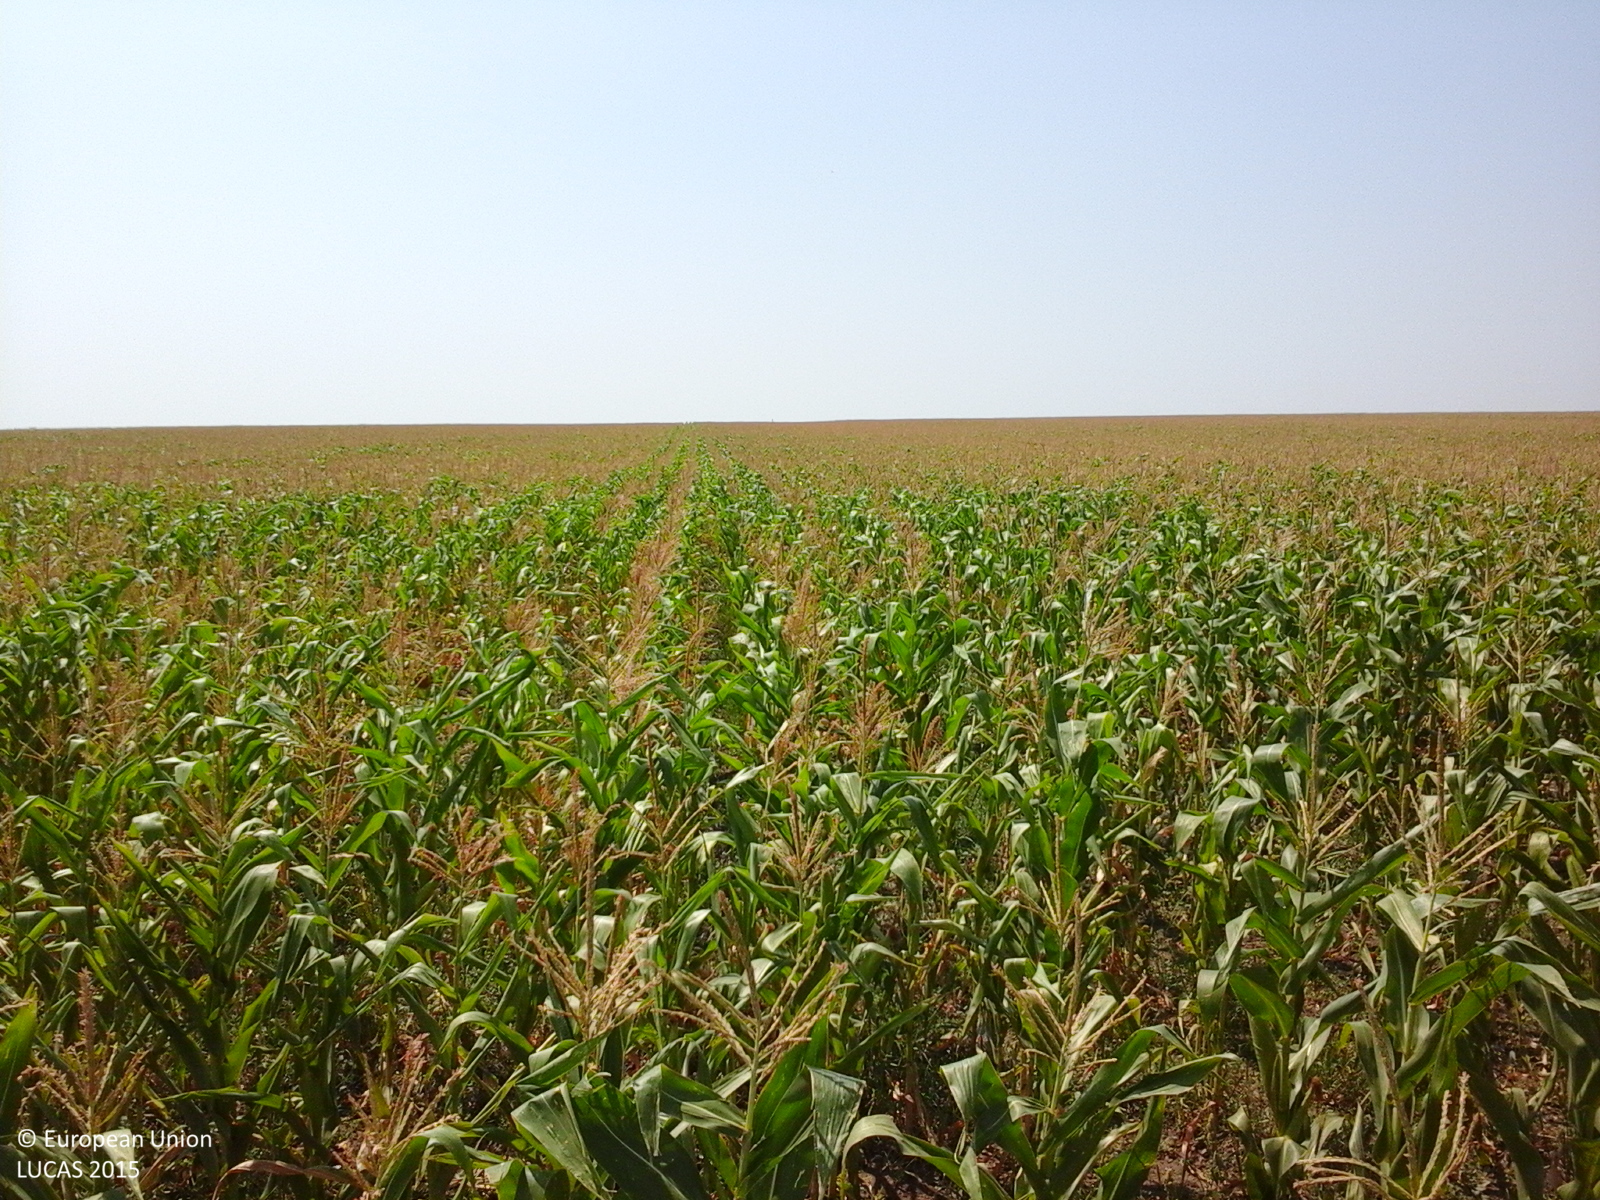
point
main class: Cropland
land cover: Maize
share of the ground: > 75 %
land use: Agriculture (excluding fallow land and kitchen gardens)
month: July
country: RO
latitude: 45.7306
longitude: 27.9943
